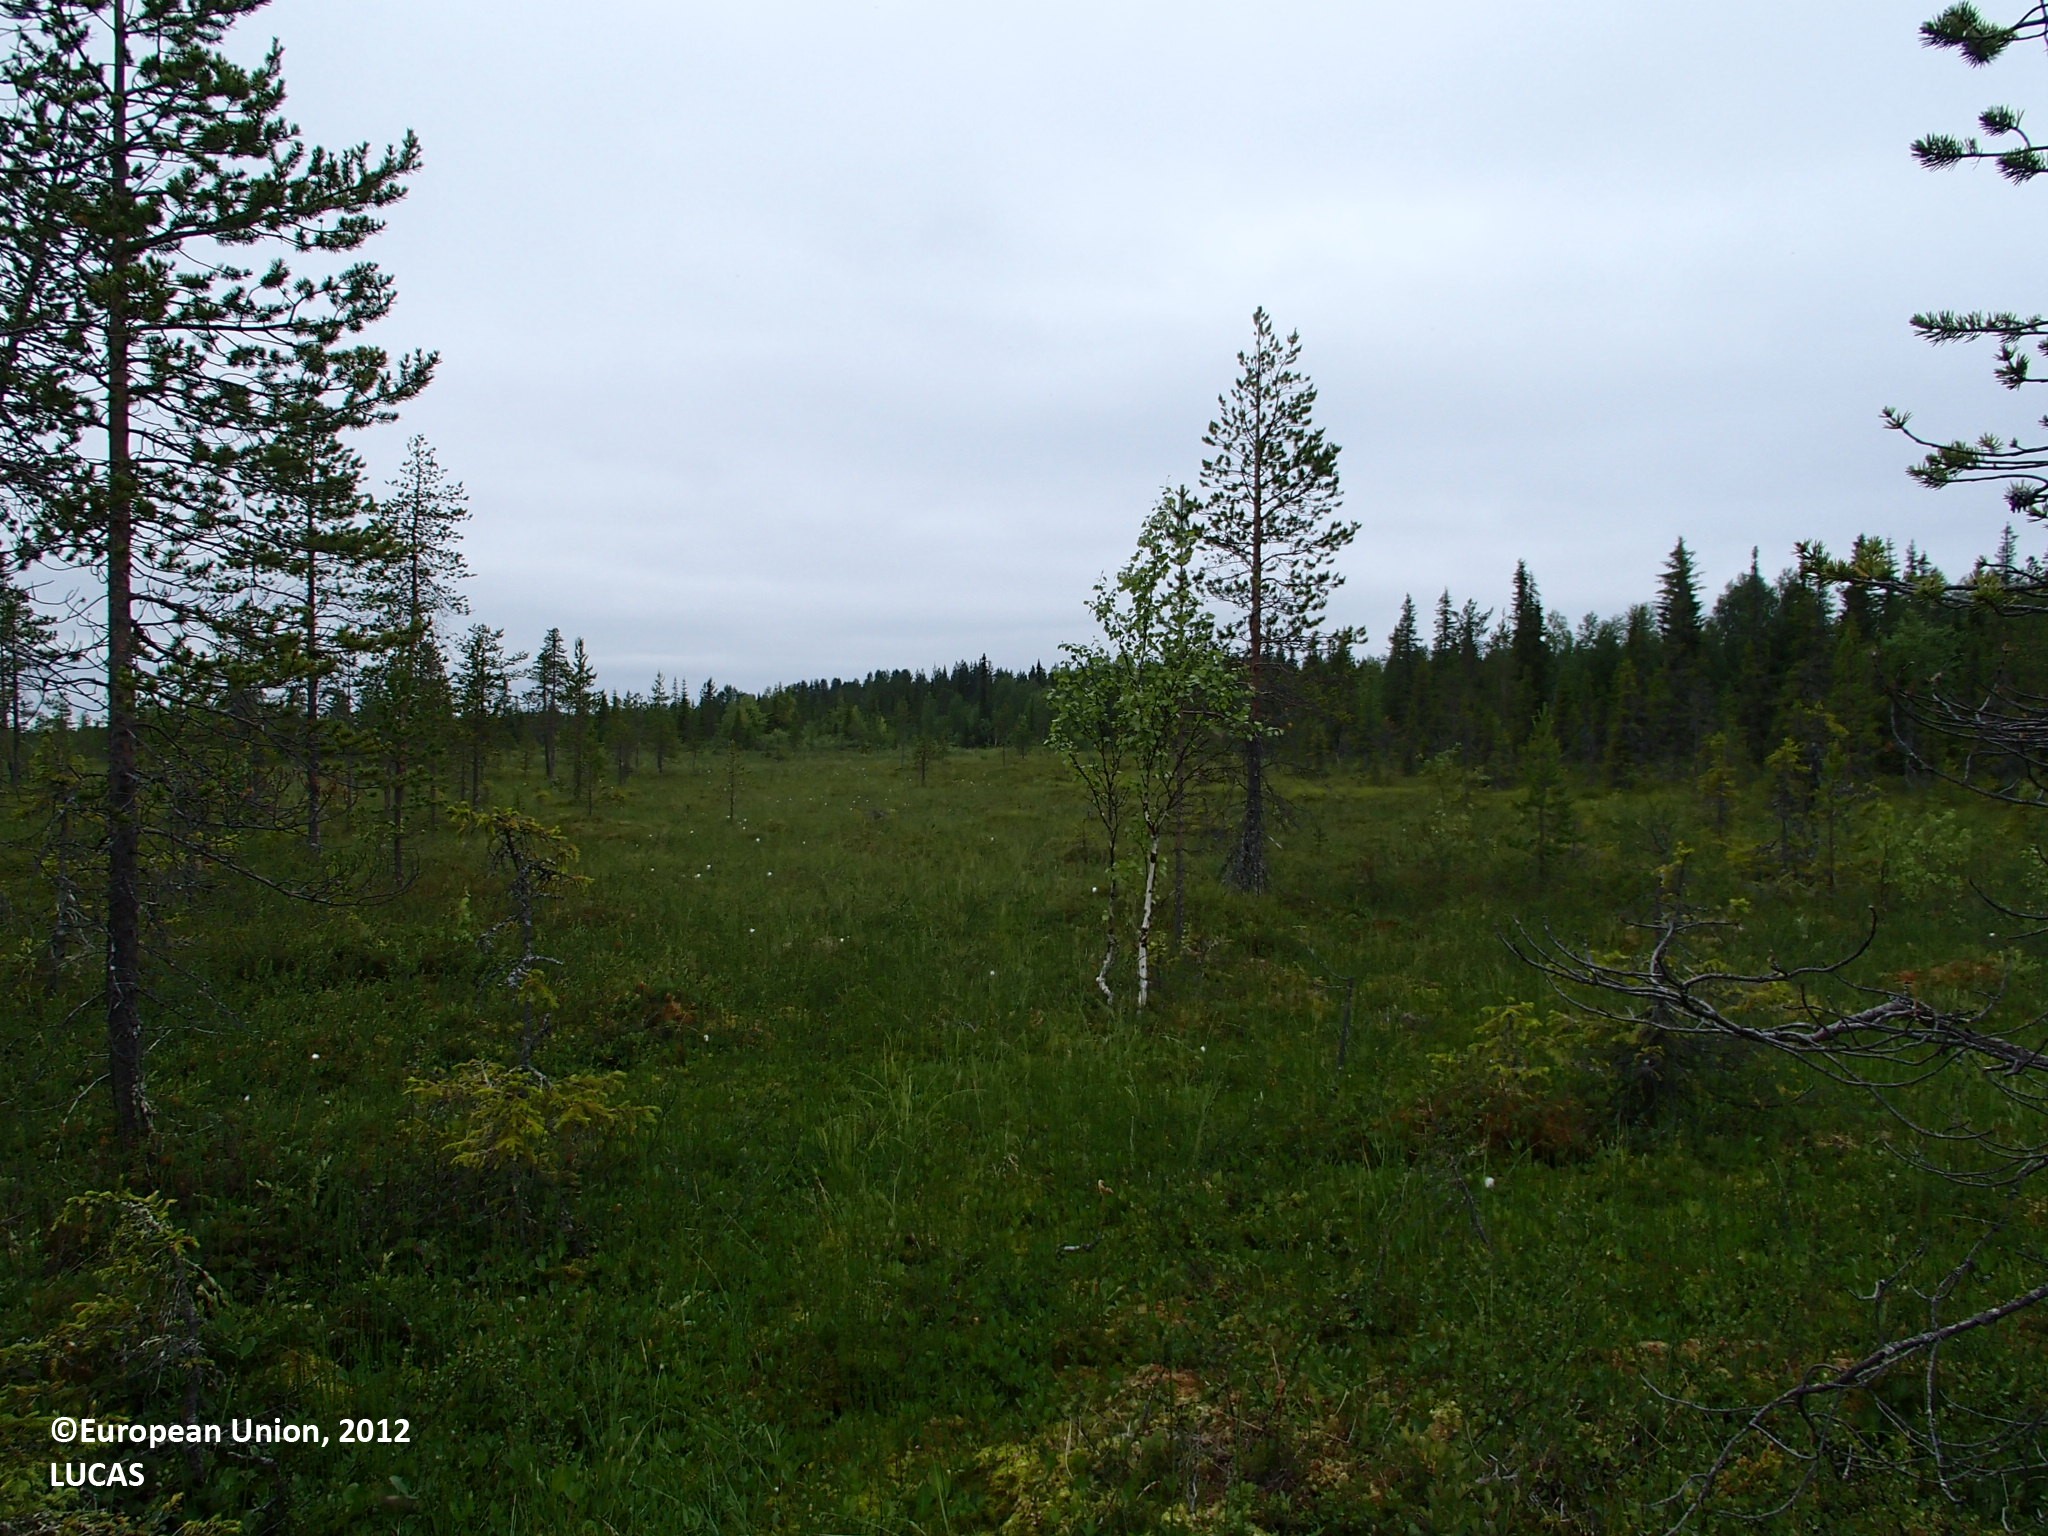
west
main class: Woodland
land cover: Pine dominated coniferous woodland
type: boreal forest
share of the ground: 10 - 25 %
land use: Forestry
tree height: > 5 m
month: July
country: FI
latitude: 67.3488
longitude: 25.9534
